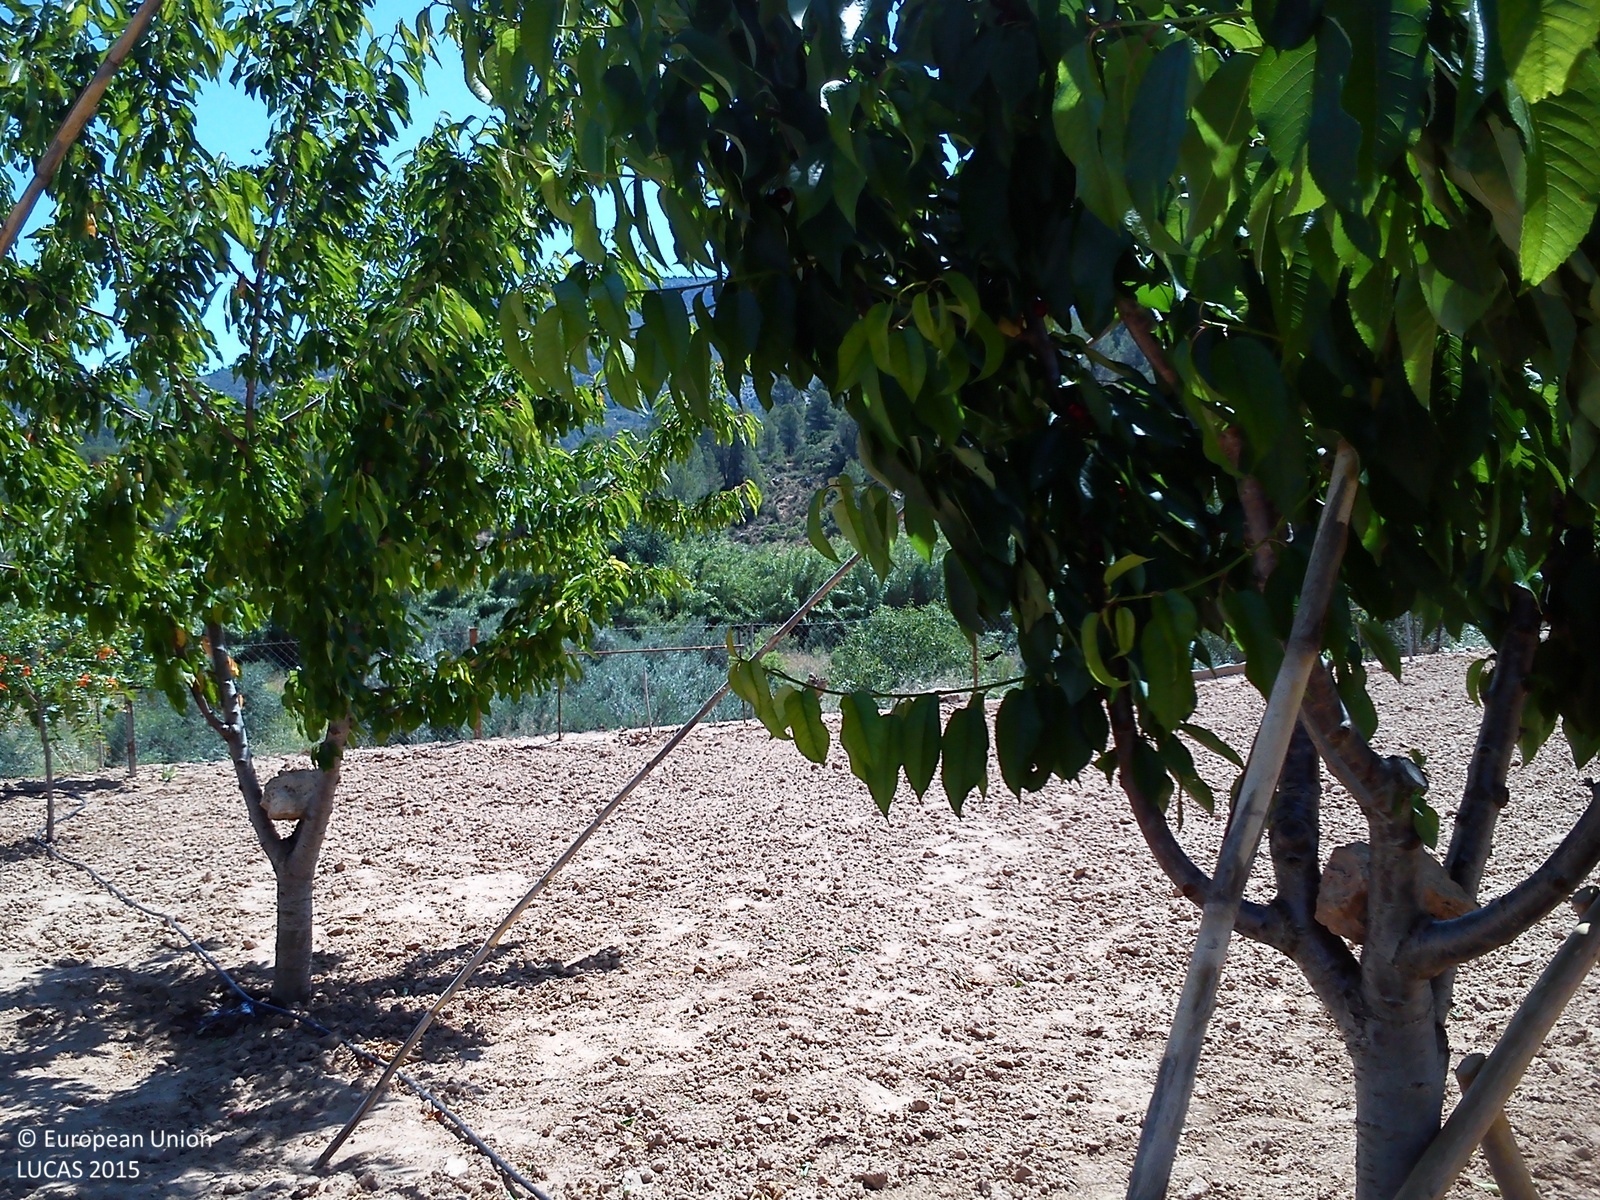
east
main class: Cropland
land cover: Cherry fruit
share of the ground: 10 - 25 %
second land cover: Other bare soil
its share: > 75 %
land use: Agriculture (excluding fallow land and kitchen gardens)
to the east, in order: Cherry fruit; Other bare soil; Fences; Shrubland with sparse tree cover; Olive groves; Shrubland with sparse tree cover; Shrubland without tree cover; Inland fresh running water; Shrubland with sparse tree cover; Tracks; Pine dominated coniferous woodland
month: June
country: ES
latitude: 39.2203
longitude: -1.0595
